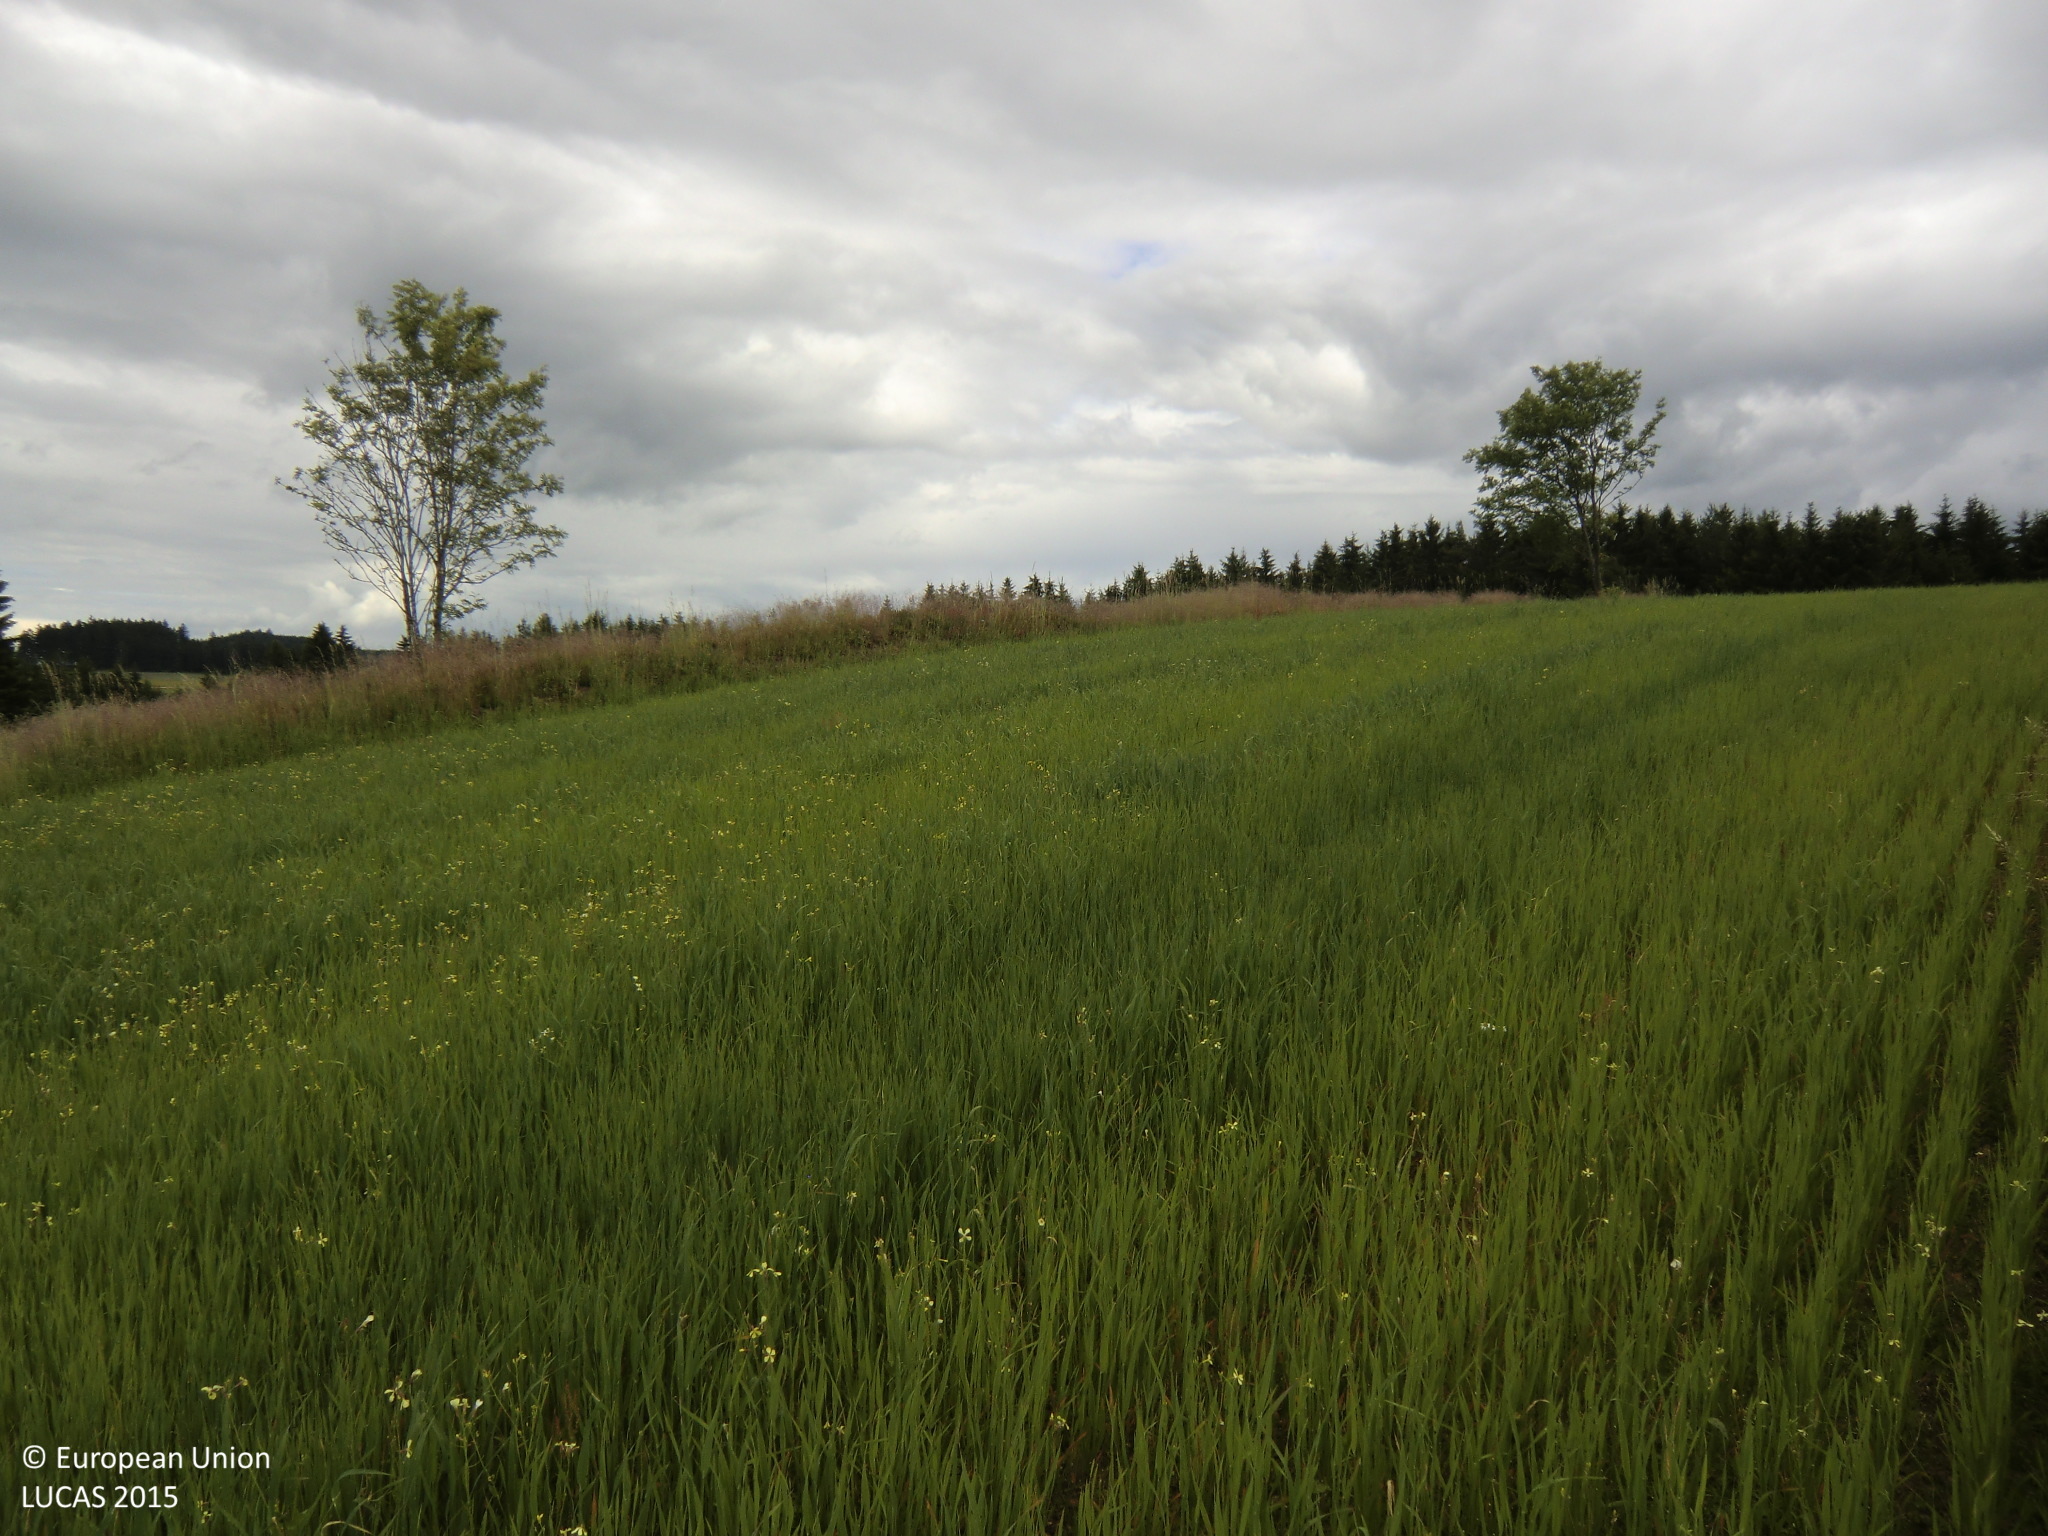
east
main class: Cropland
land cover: Rye
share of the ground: > 75 %
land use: Agriculture (excluding fallow land and kitchen gardens)
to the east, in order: Grass margins; Rye; Grassland without tree/shrub cover; Temporary grasslands; Grass margins; Temporary grasslands; Common wheat; Grass margins; Rye; Grassland without tree/shrub cover; Spruce dominated coniferous woodland; Tracks; Spruce dominated coniferous woodland
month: June
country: AT
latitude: 48.4351
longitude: 14.9891
